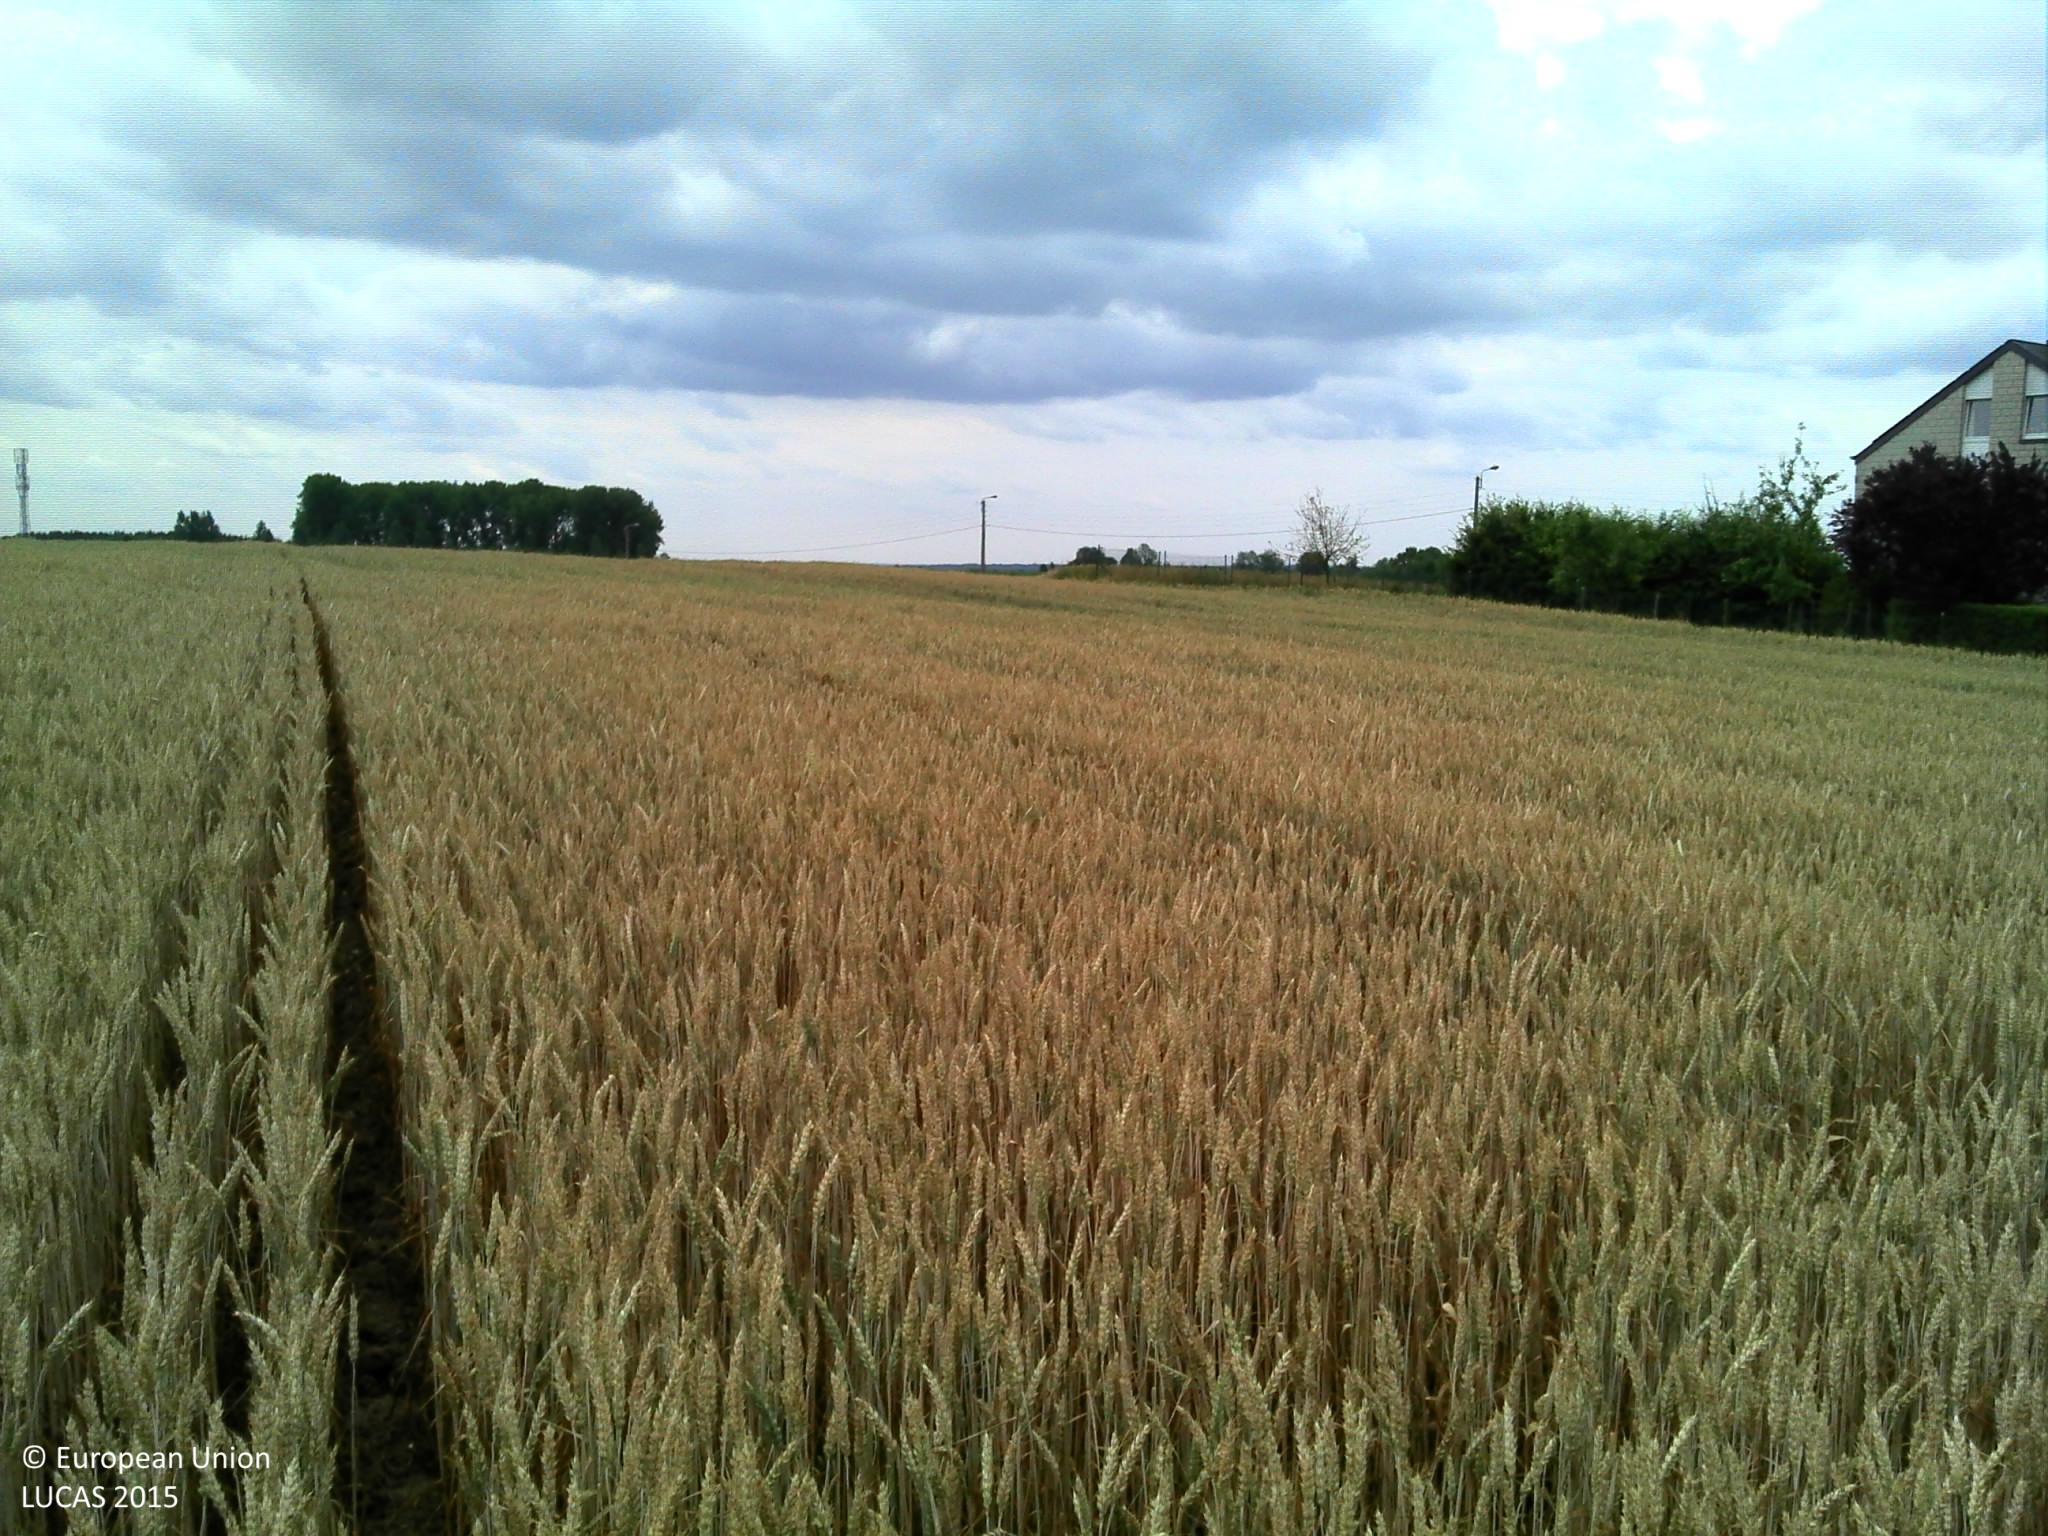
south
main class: Cropland
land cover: Common wheat
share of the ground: > 75 %
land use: Agriculture (excluding fallow land and kitchen gardens)
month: July
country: BE
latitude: 49.7223
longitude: 5.6293
